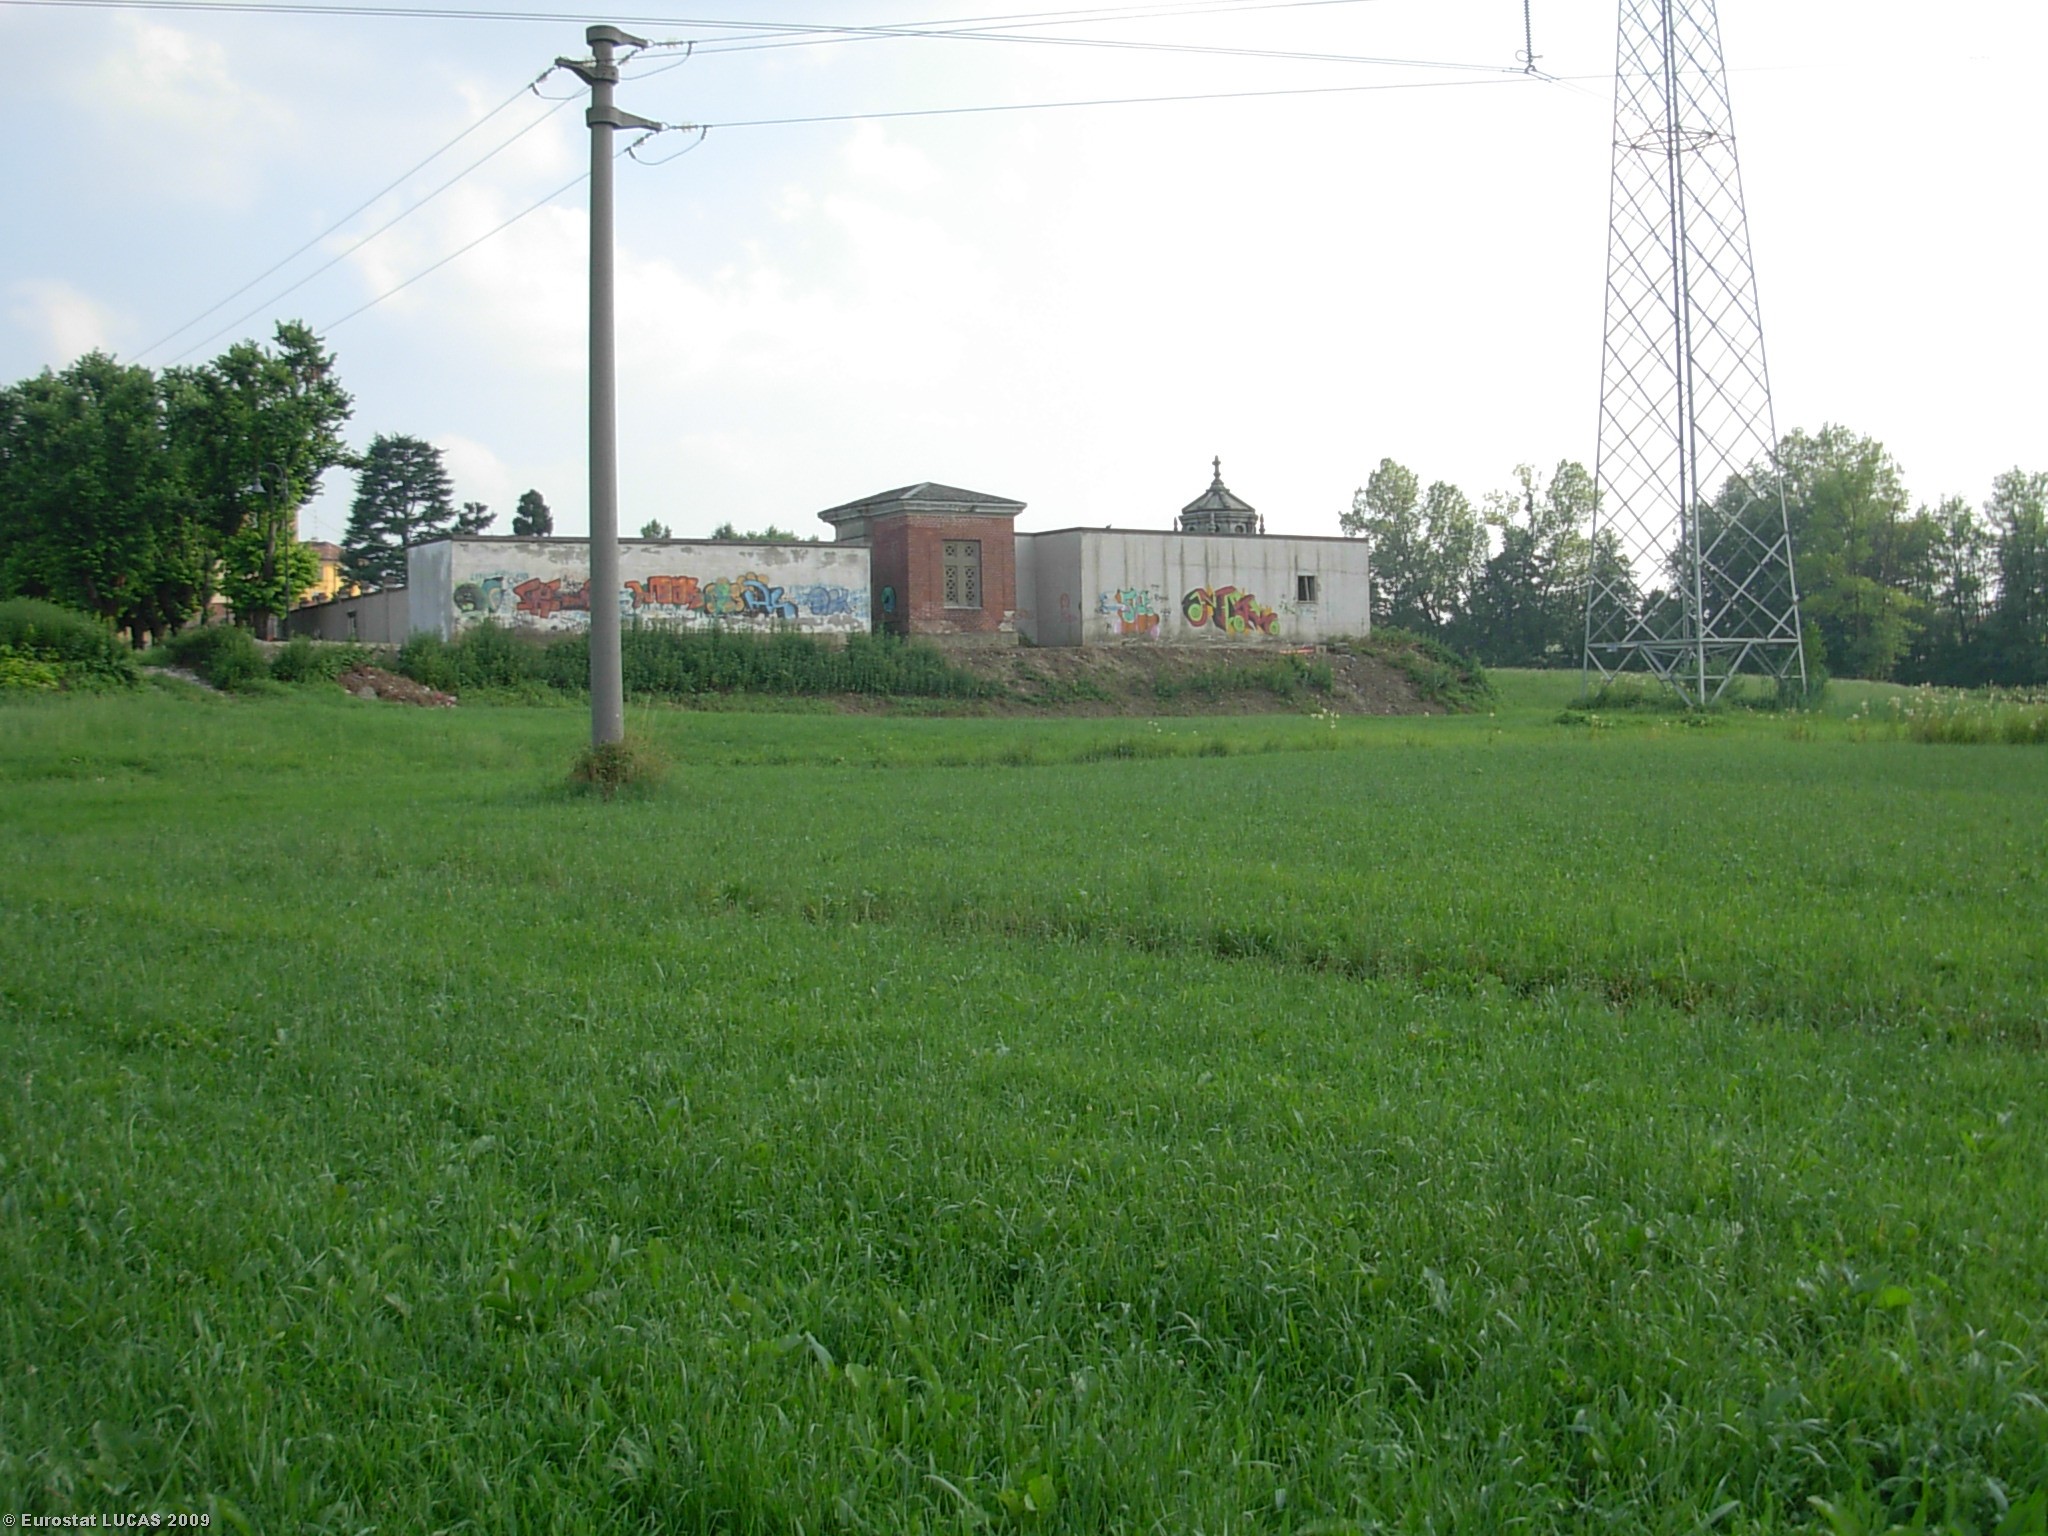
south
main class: Grassland
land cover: Grassland without tree/shrub cover
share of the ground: > 75 %
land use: Agriculture (excluding fallow land and kitchen gardens)
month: June
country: IT
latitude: 45.7183
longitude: 9.2945
